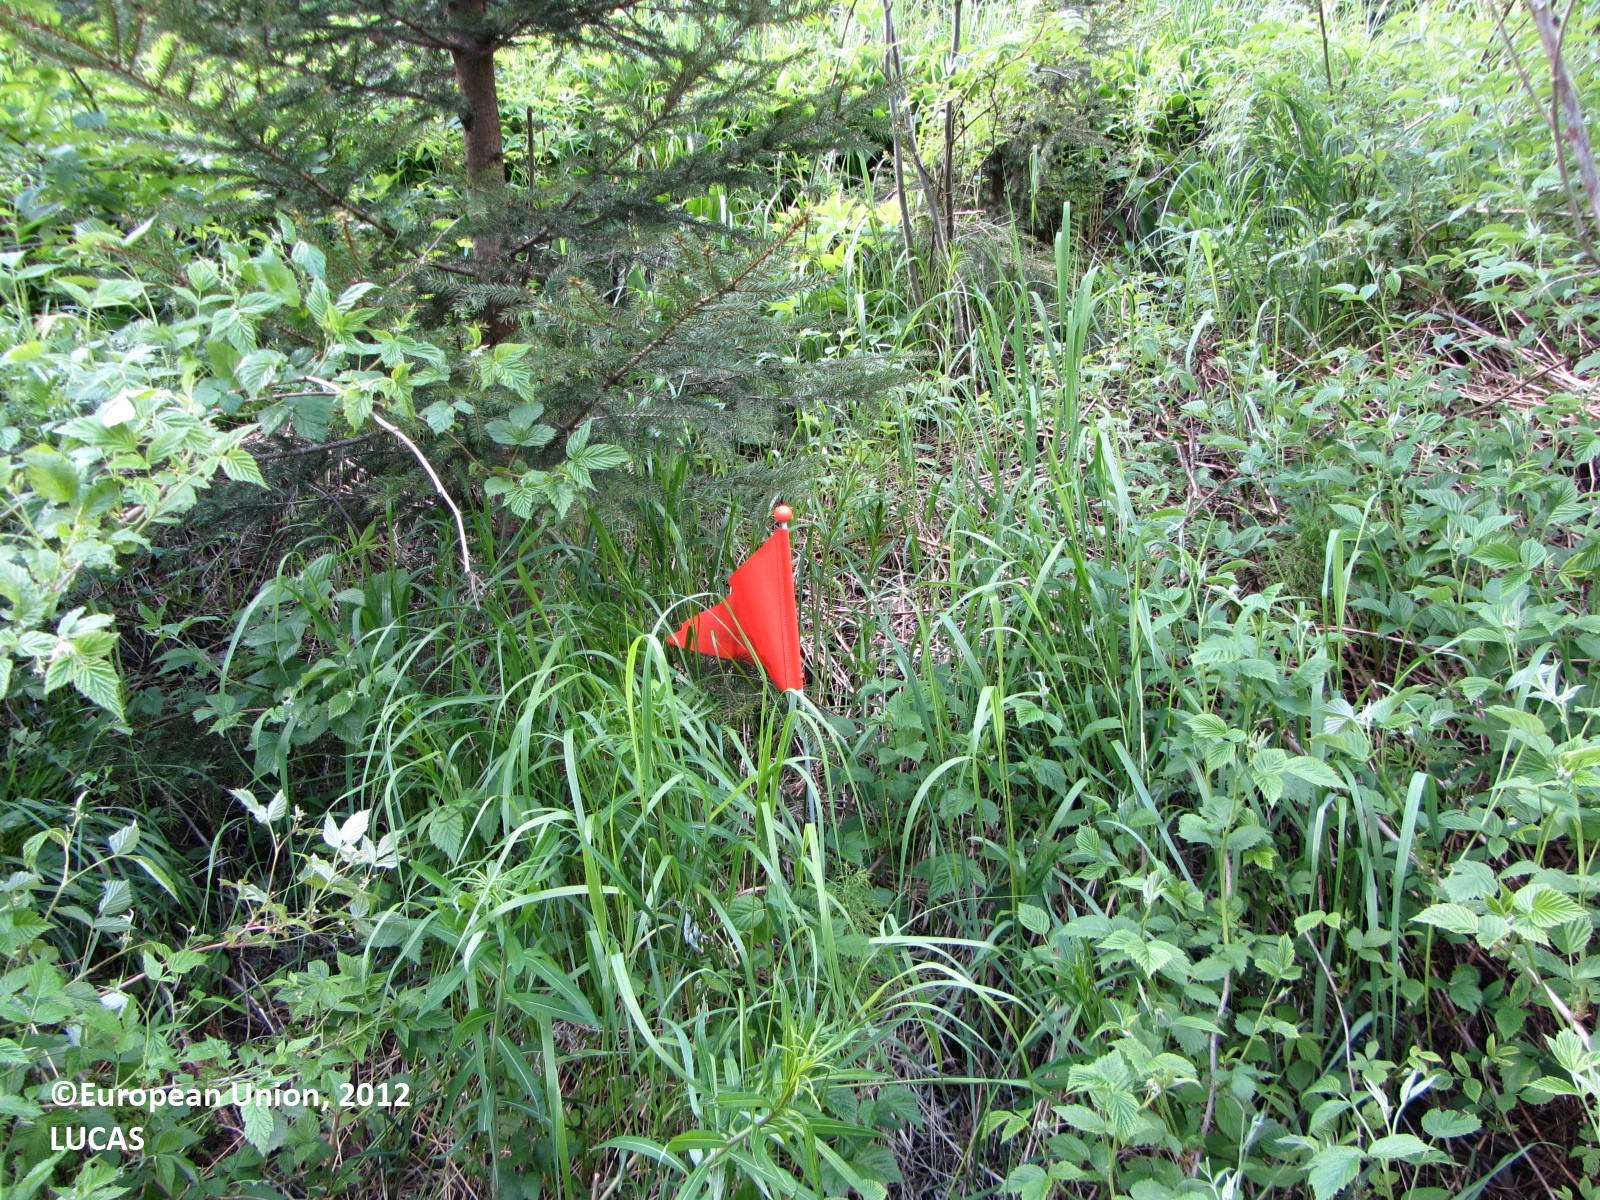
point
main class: Woodland
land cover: Spruce dominated mixed woodland
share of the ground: > 75 %
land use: Forestry
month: June
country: FI
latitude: 61.8057
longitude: 25.1171
